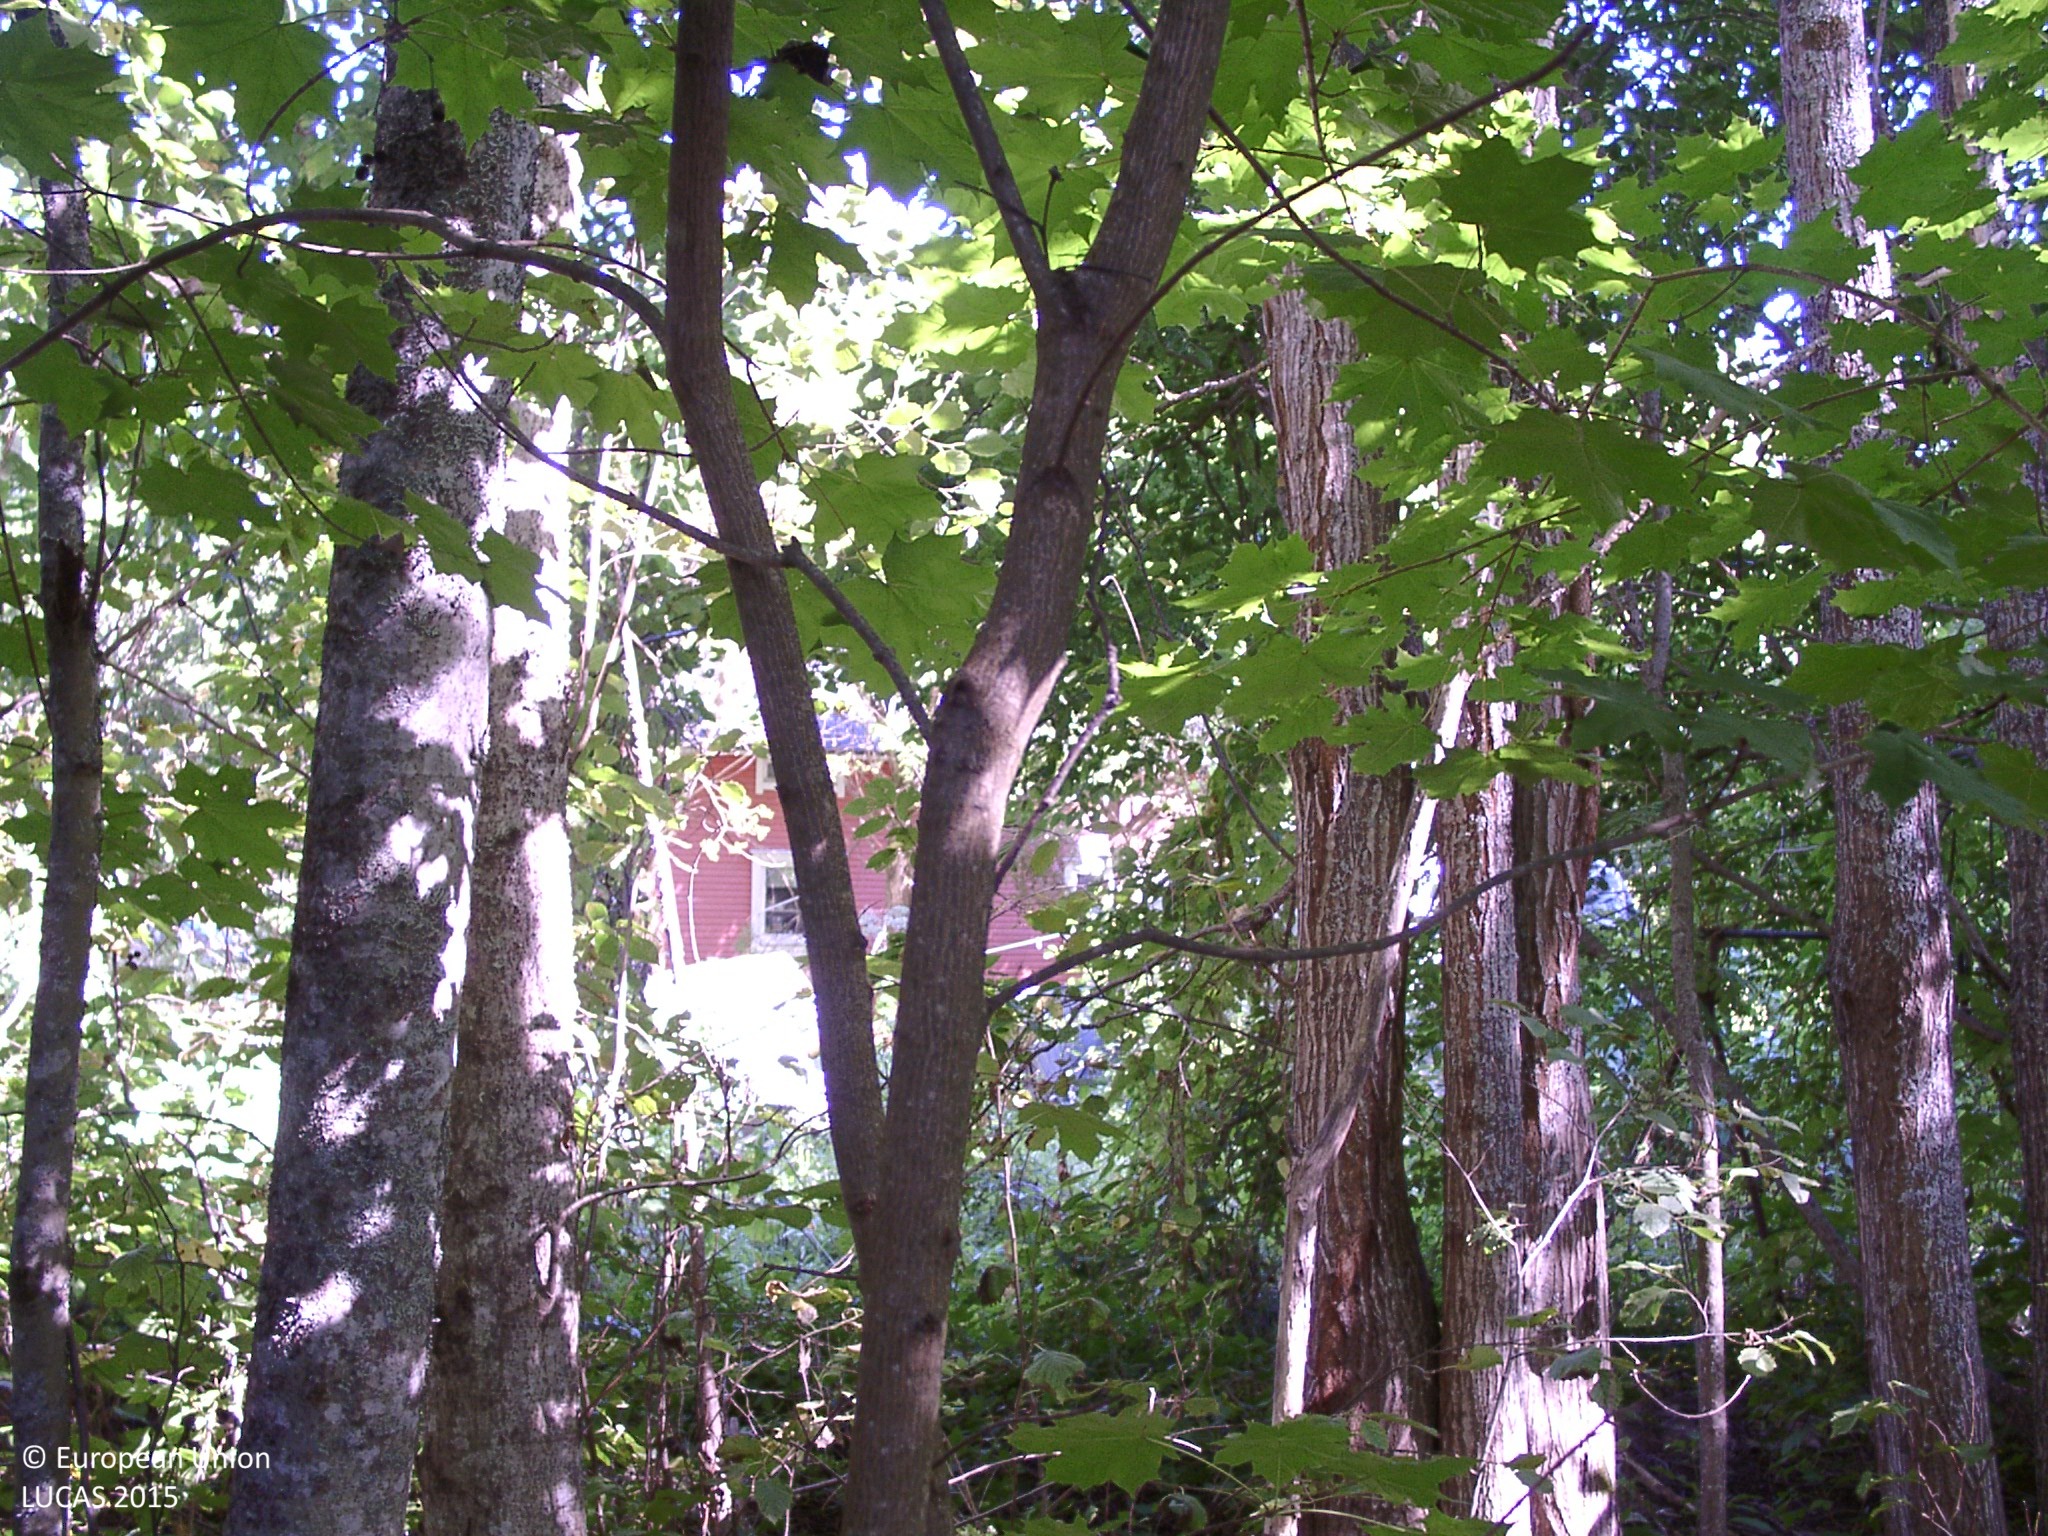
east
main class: Woodland
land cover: Broadleaved woodland
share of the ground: 50 - 75 %
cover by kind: broadleaved forest trees 50 %, shrubs 30 %, coniferous forest trees 15 %, herbaceous plants 5 %
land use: Semi-natural and natural areas not in use
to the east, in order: Broadleaved woodland; Ditches and canals; Artificial constructions in urban areas; Ditches and canals; Artificial constructions in urban areas
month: August
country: FI
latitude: 61.8583
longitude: 25.1429
